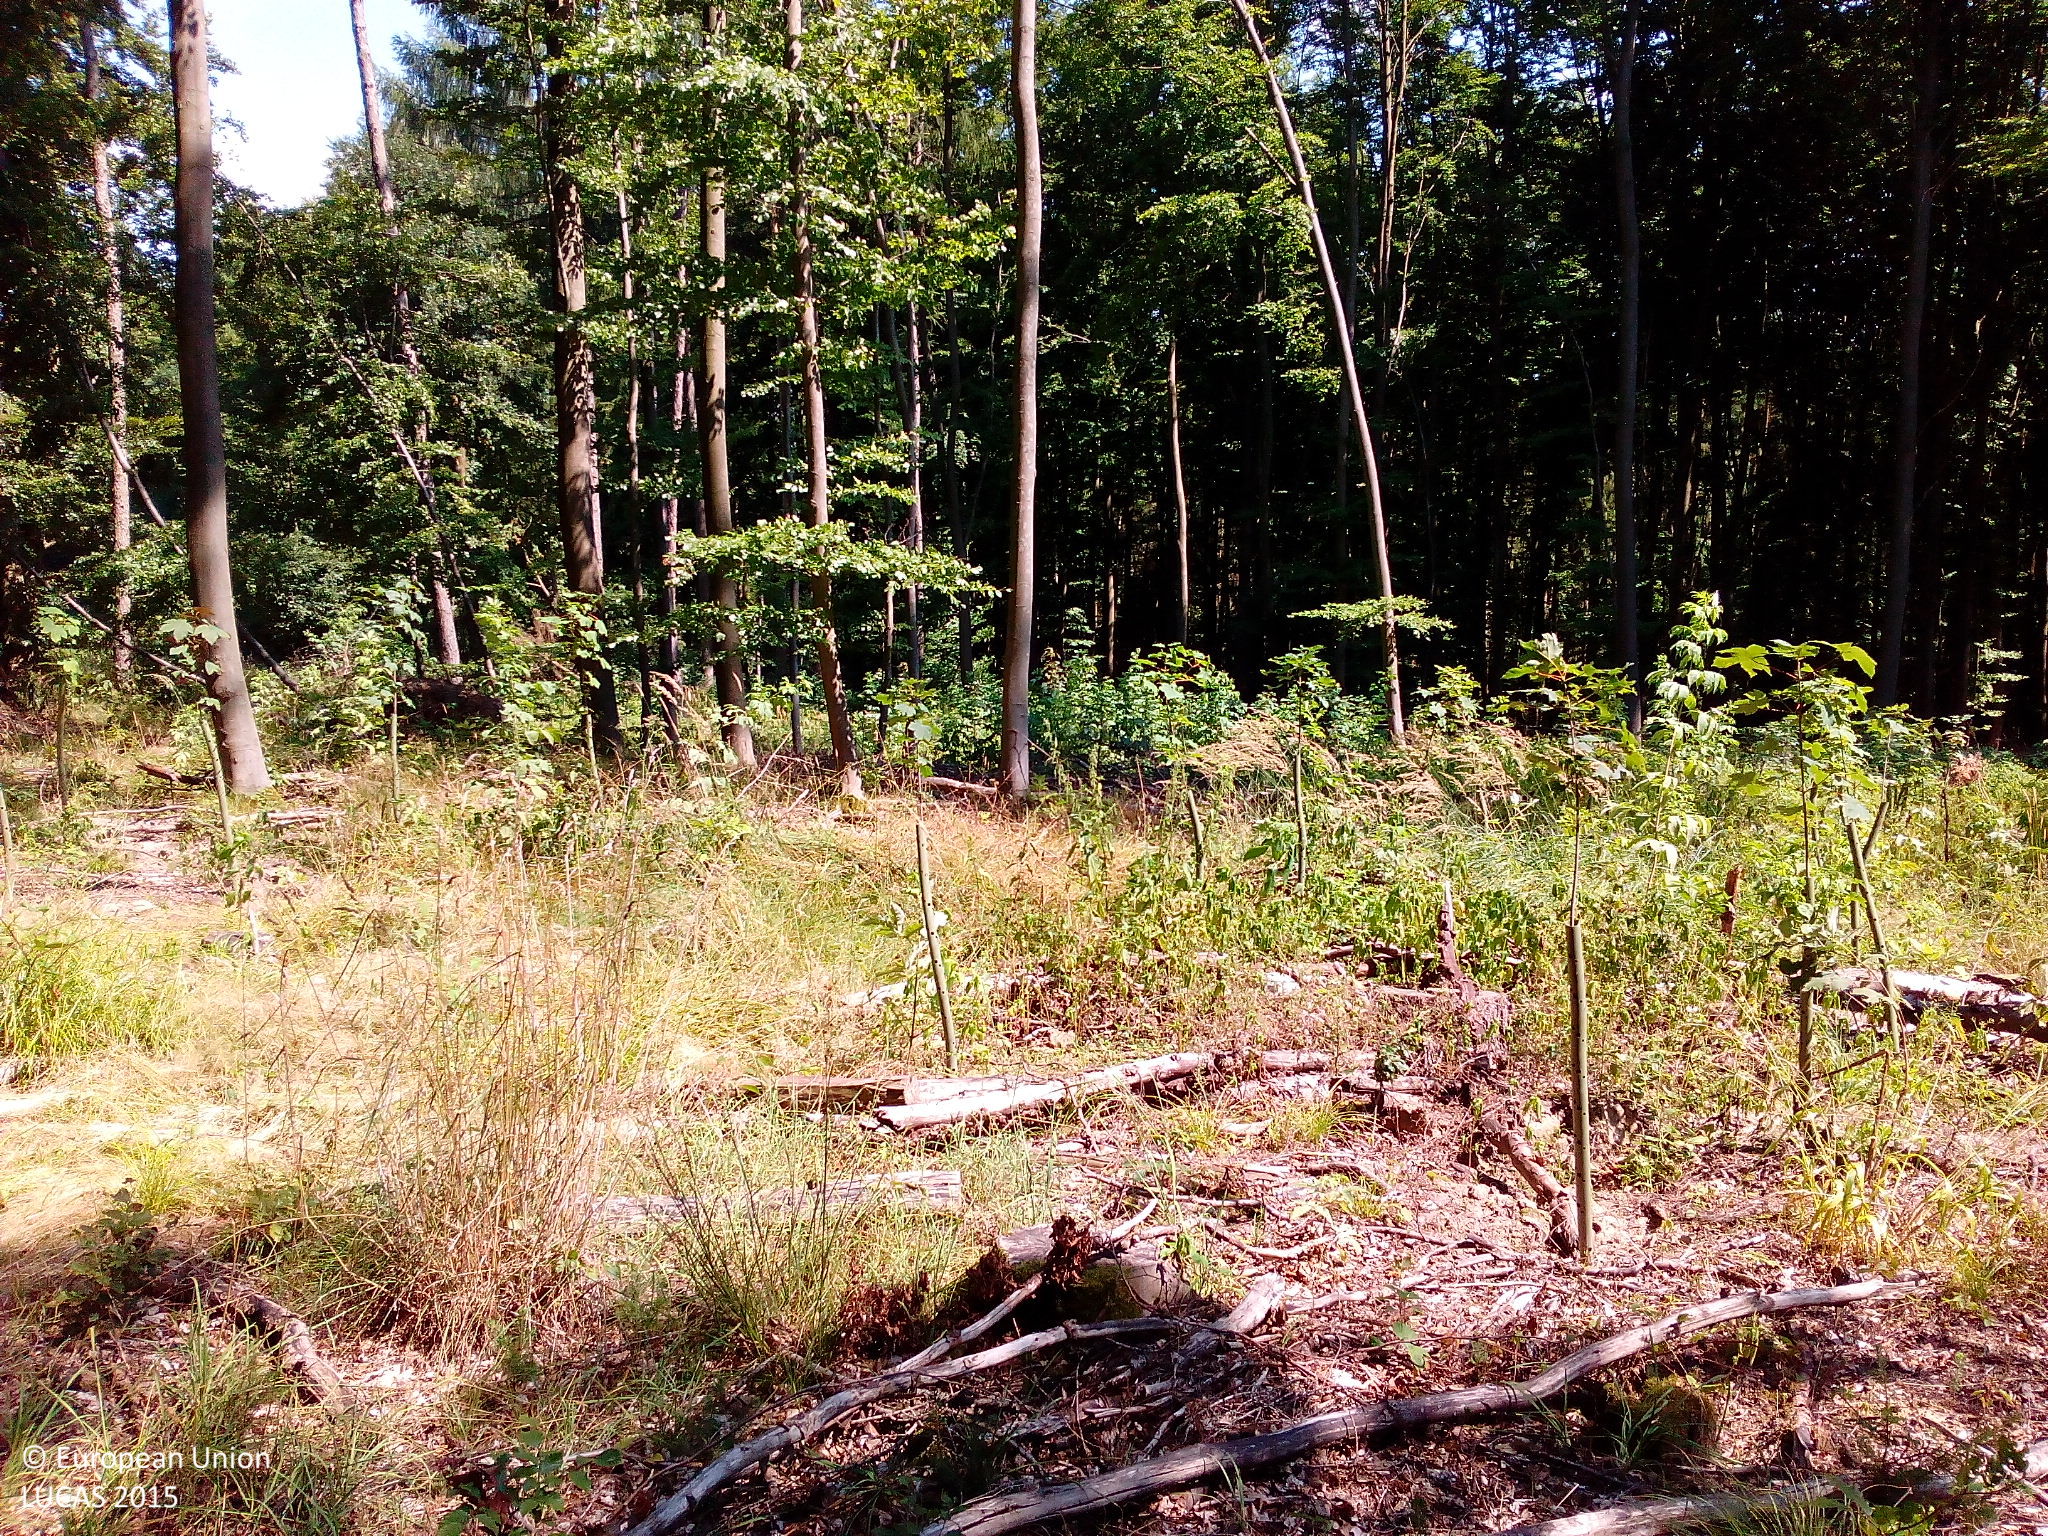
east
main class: Woodland
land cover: Broadleaved woodland
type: beech forest
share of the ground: > 75 %
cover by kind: broadleaved forest trees 90 %, herbaceous plants 5 %, unconsolidated bare surface 5 %
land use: Forestry
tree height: > 5 m
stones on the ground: < 10 %
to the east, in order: Broadleaved woodland; Tracks; Broadleaved woodland; Spruce dominated mixed woodland; Ditches and canals; Tracks; Spruce dominated mixed woodland; Broadleaved woodland; Tracks; Broadleaved woodland
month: August
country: DE
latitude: 50.7397
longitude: 9.3342
